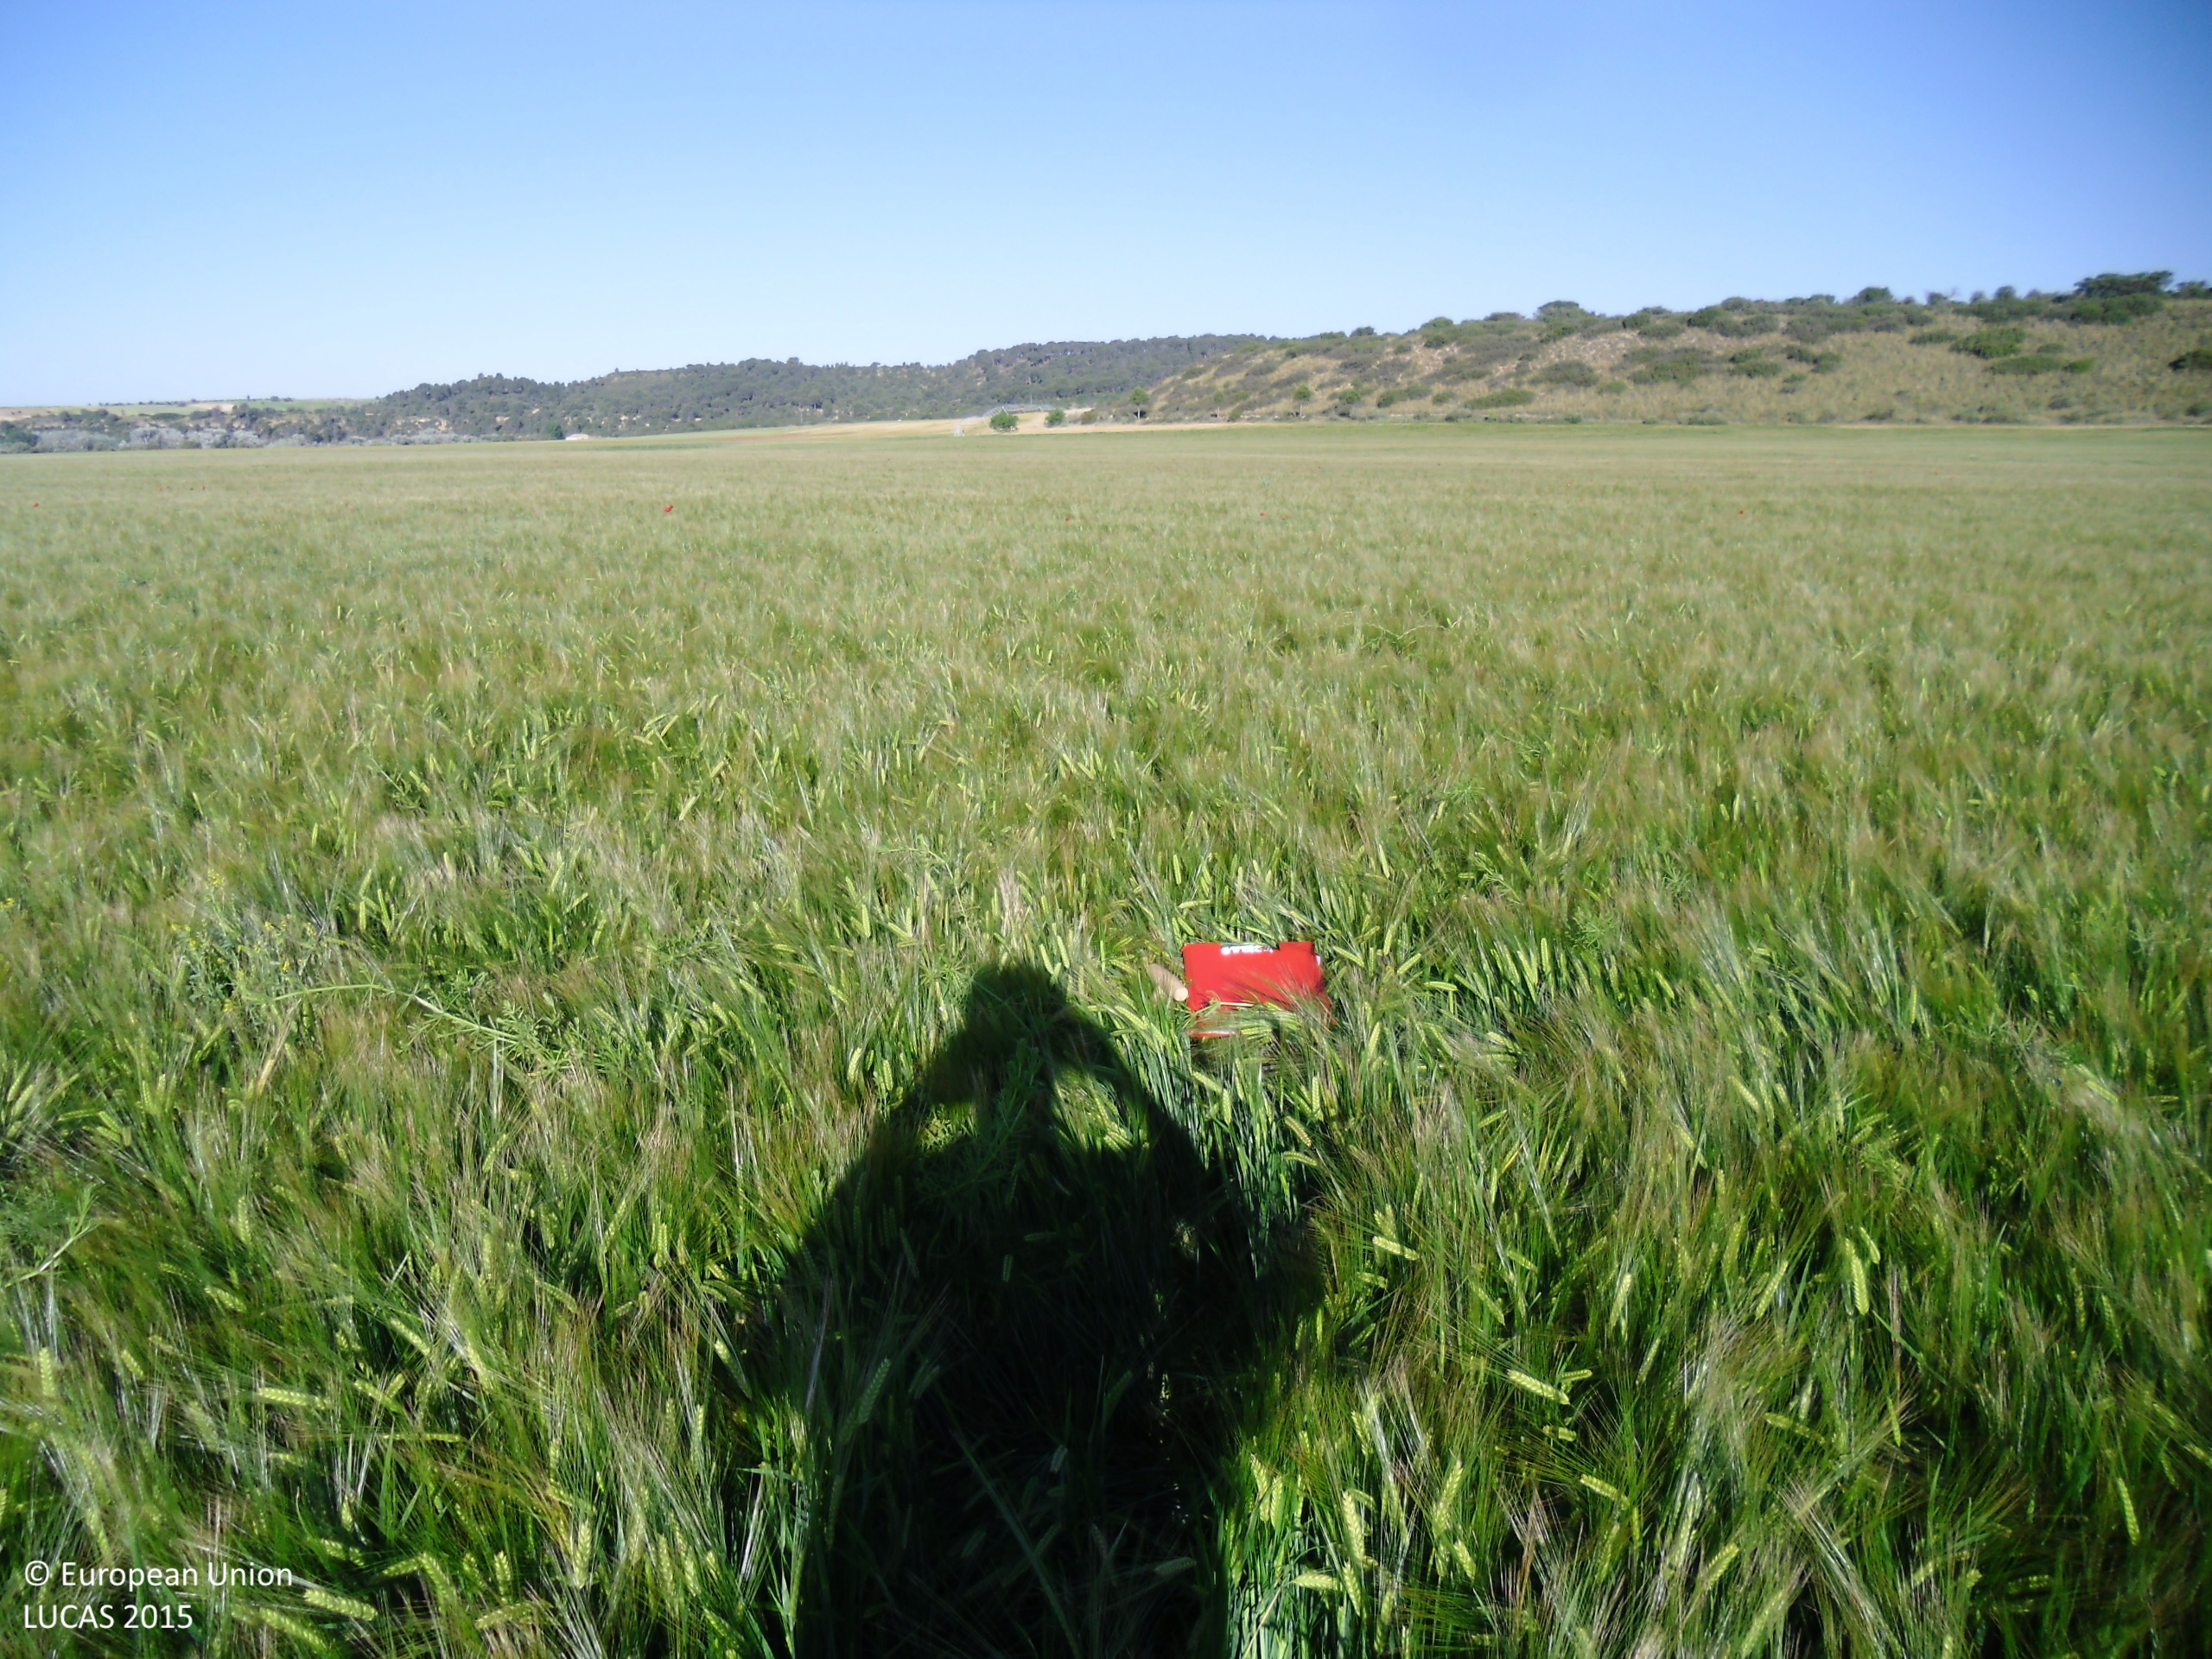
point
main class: Cropland
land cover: Barley
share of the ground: > 75 %
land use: Agriculture (excluding fallow land and kitchen gardens)
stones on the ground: > 50 %
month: May
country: ES
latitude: 40.3278
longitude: -2.8908
